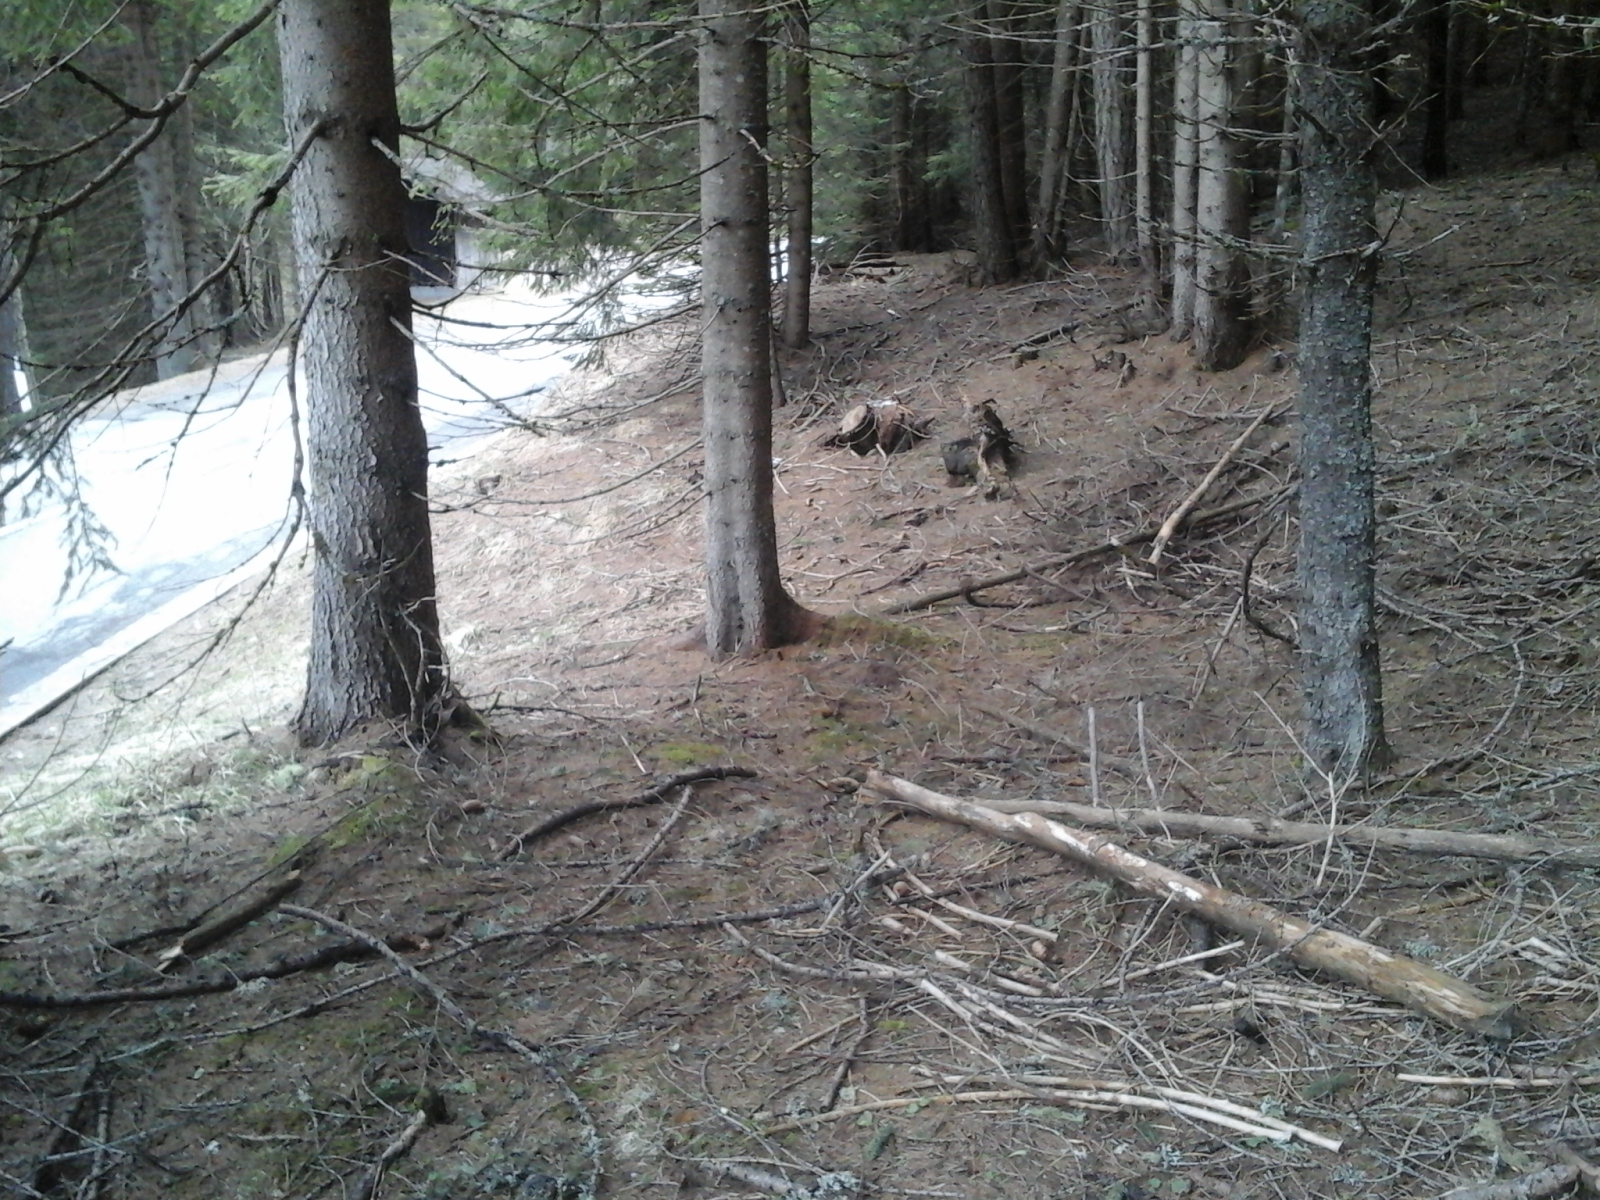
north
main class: Woodland
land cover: Spruce dominated coniferous woodland
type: alpine coniferous forest
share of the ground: > 75 %
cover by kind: coniferous forest trees 95 %, herbaceous plants 5 %
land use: Forestry
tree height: > 5 m
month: May
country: IT
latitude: 46.4293
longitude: 11.5987
